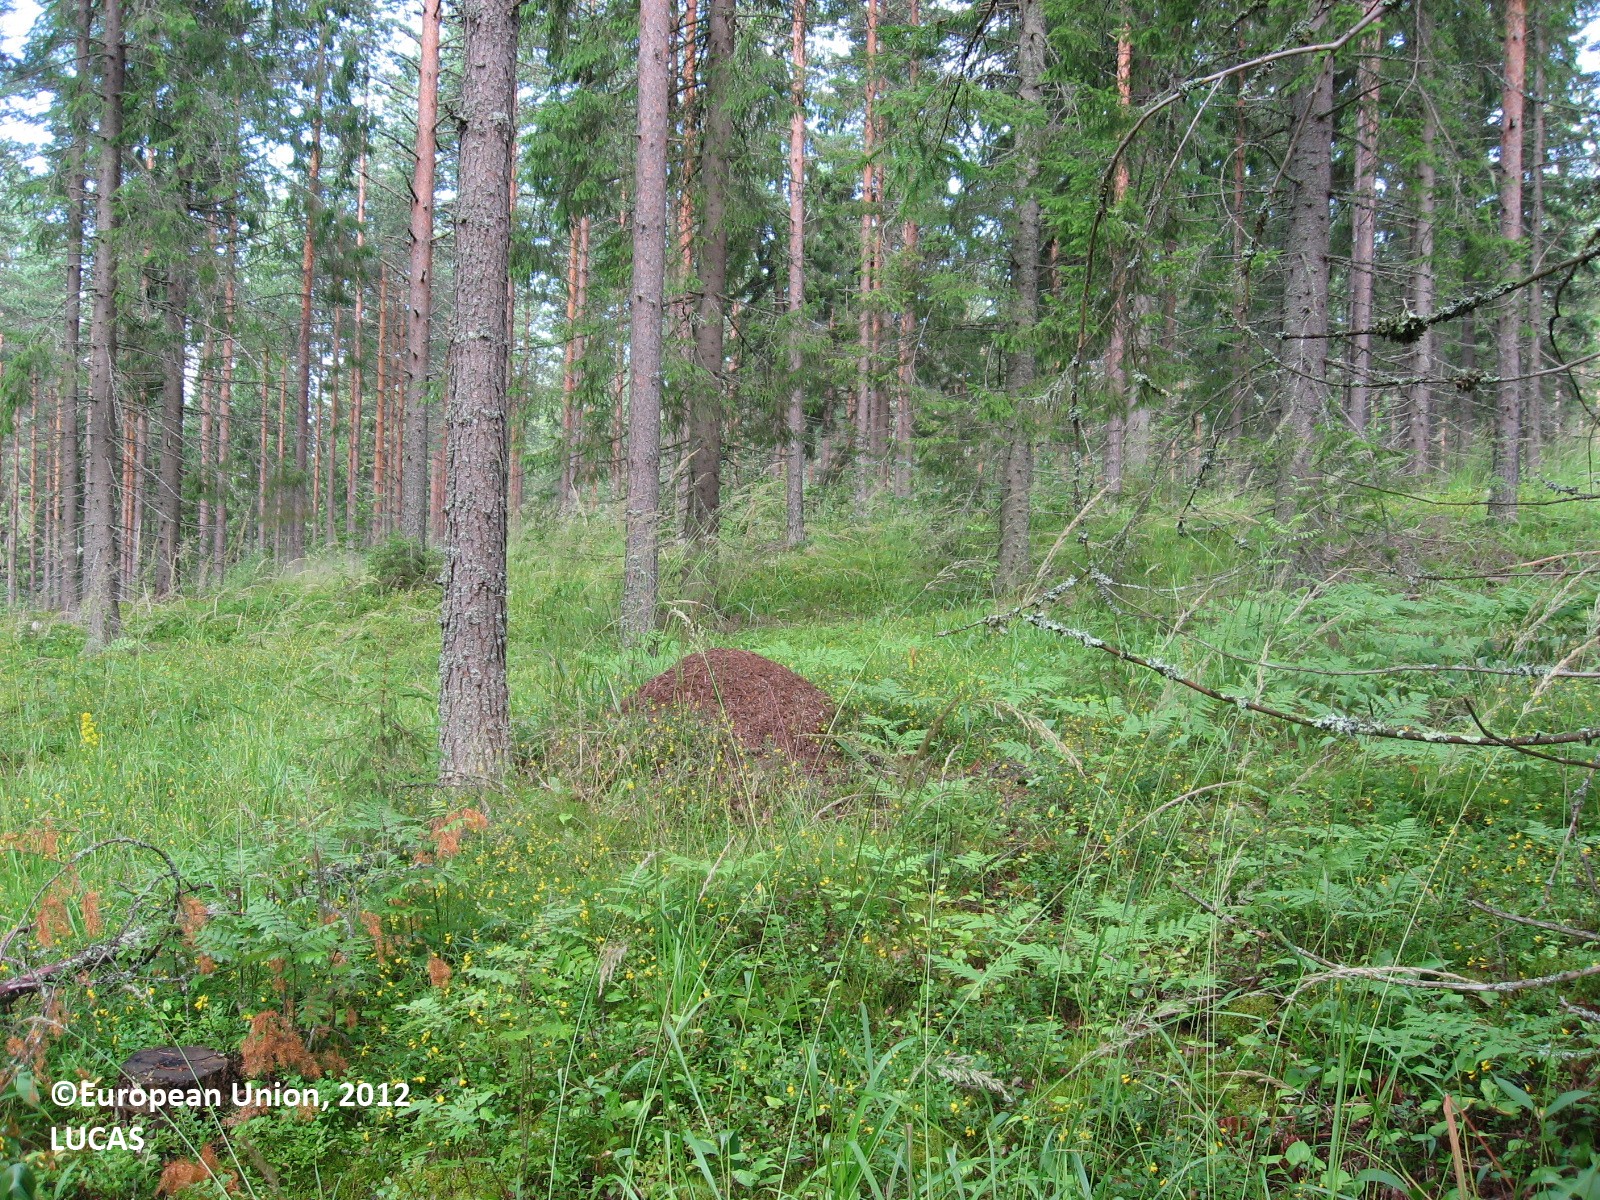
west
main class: Woodland
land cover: Spruce dominated coniferous woodland
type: boreal forest
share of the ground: 25 - 50 %
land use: Forestry
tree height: > 5 m
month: July
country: FI
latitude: 61.2447
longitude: 26.5301
